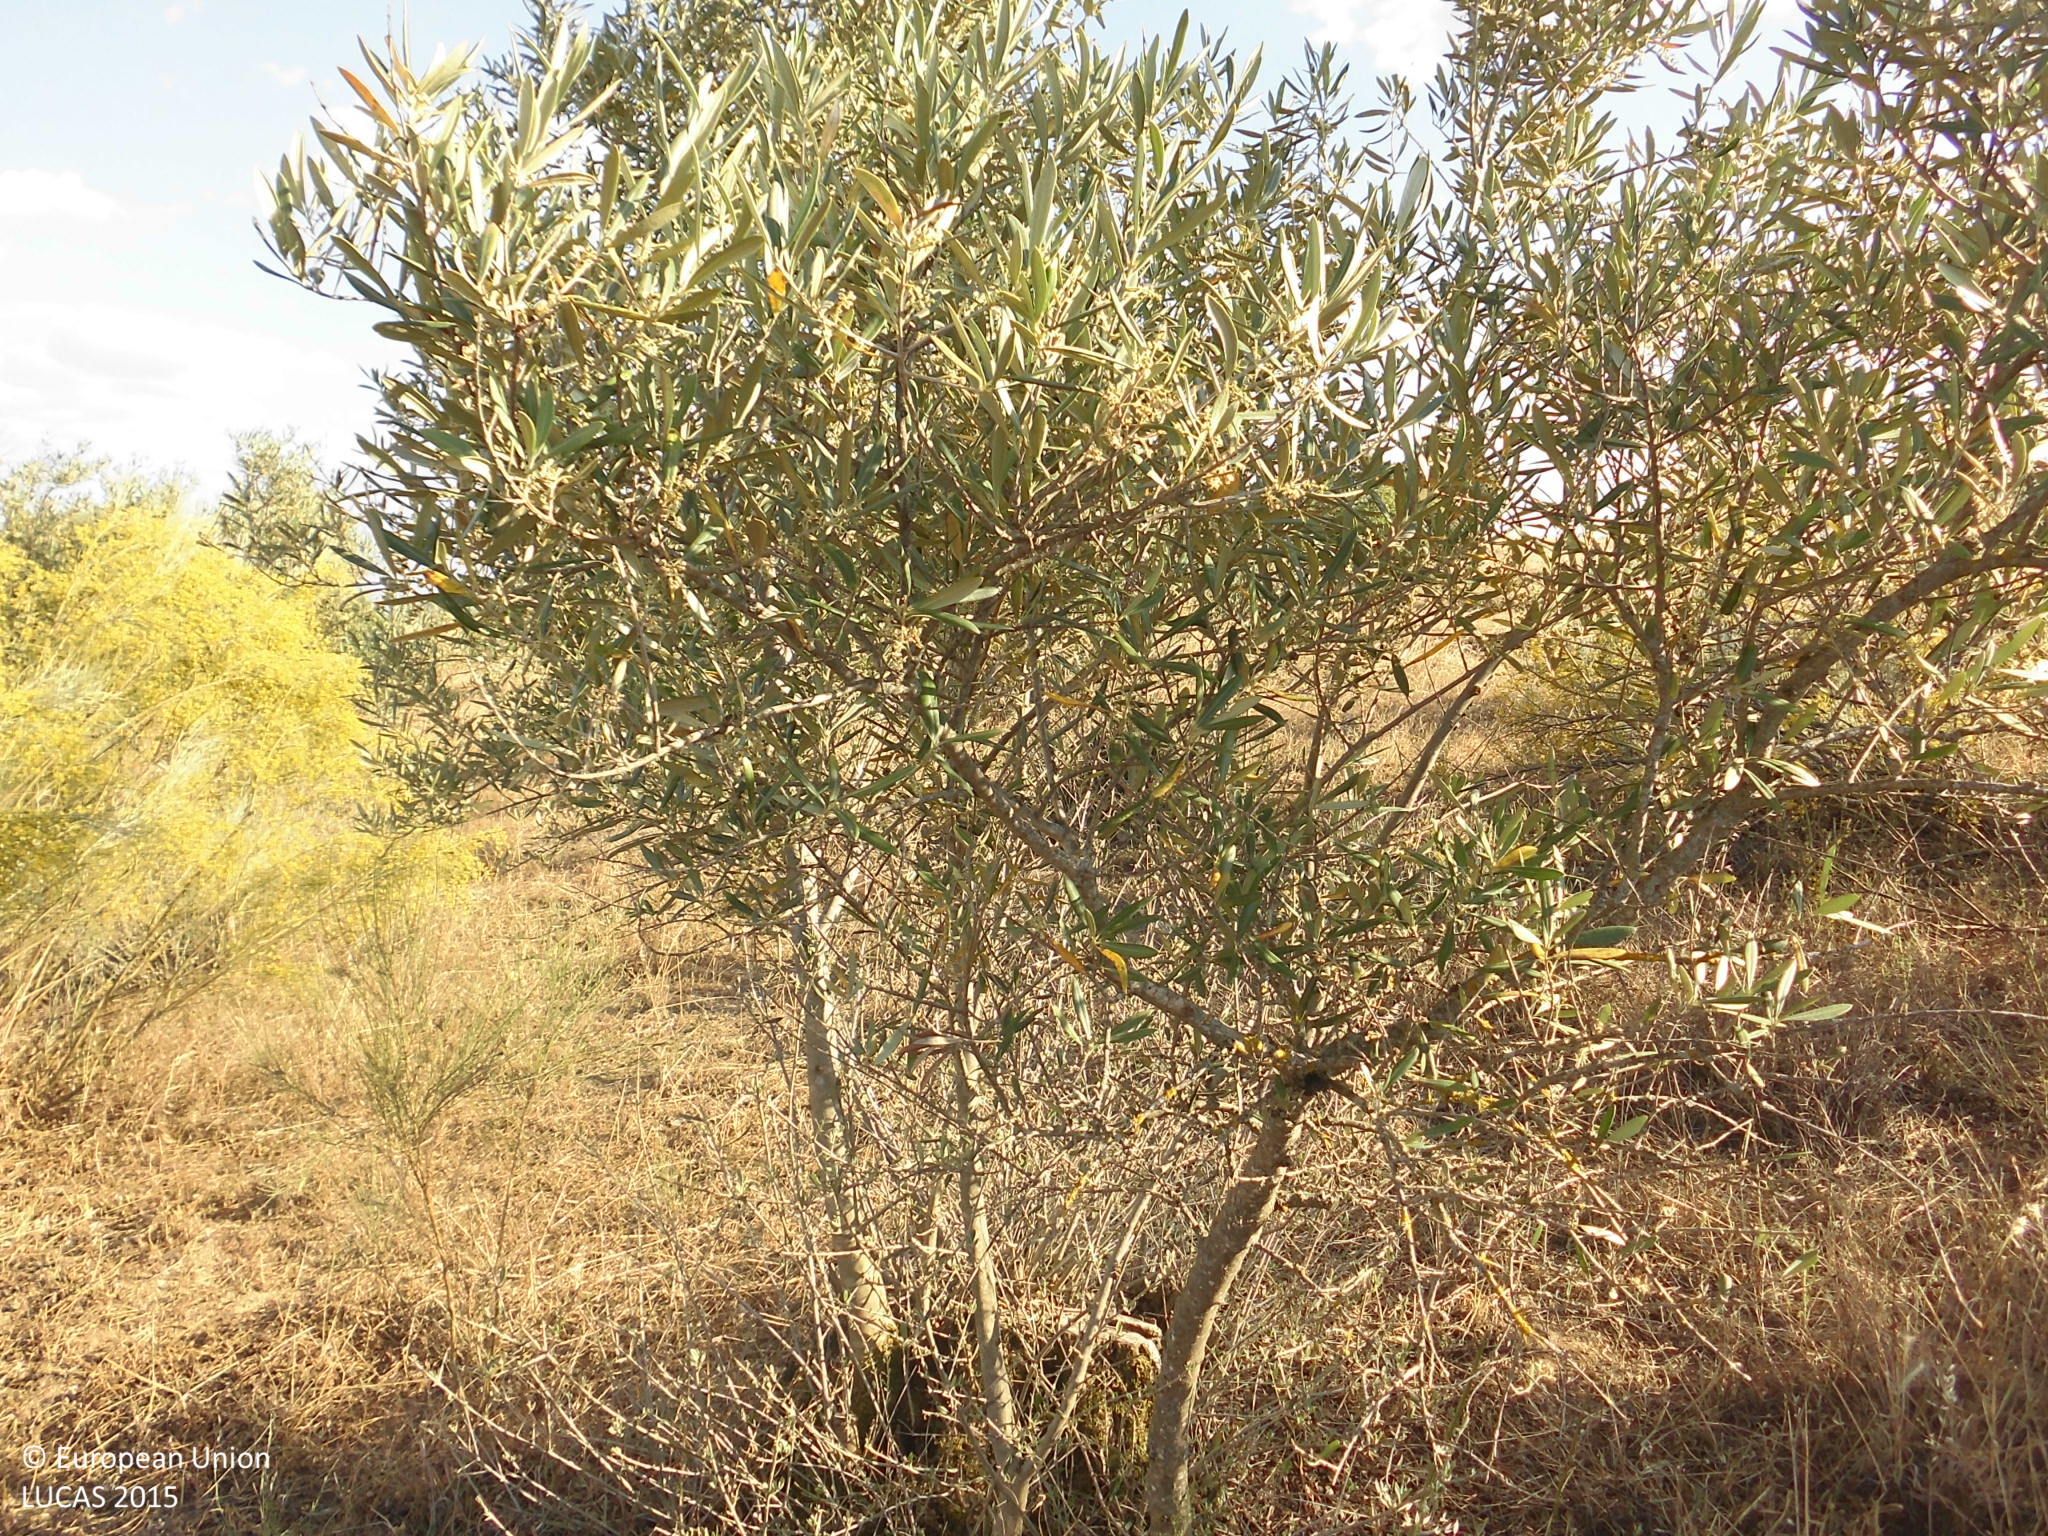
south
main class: Cropland
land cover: Olive groves
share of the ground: > 75 %
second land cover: Shrubland without tree cover
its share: > 75 %
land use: Abandoned areas
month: May
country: ES
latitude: 39.5858
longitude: -6.6676
